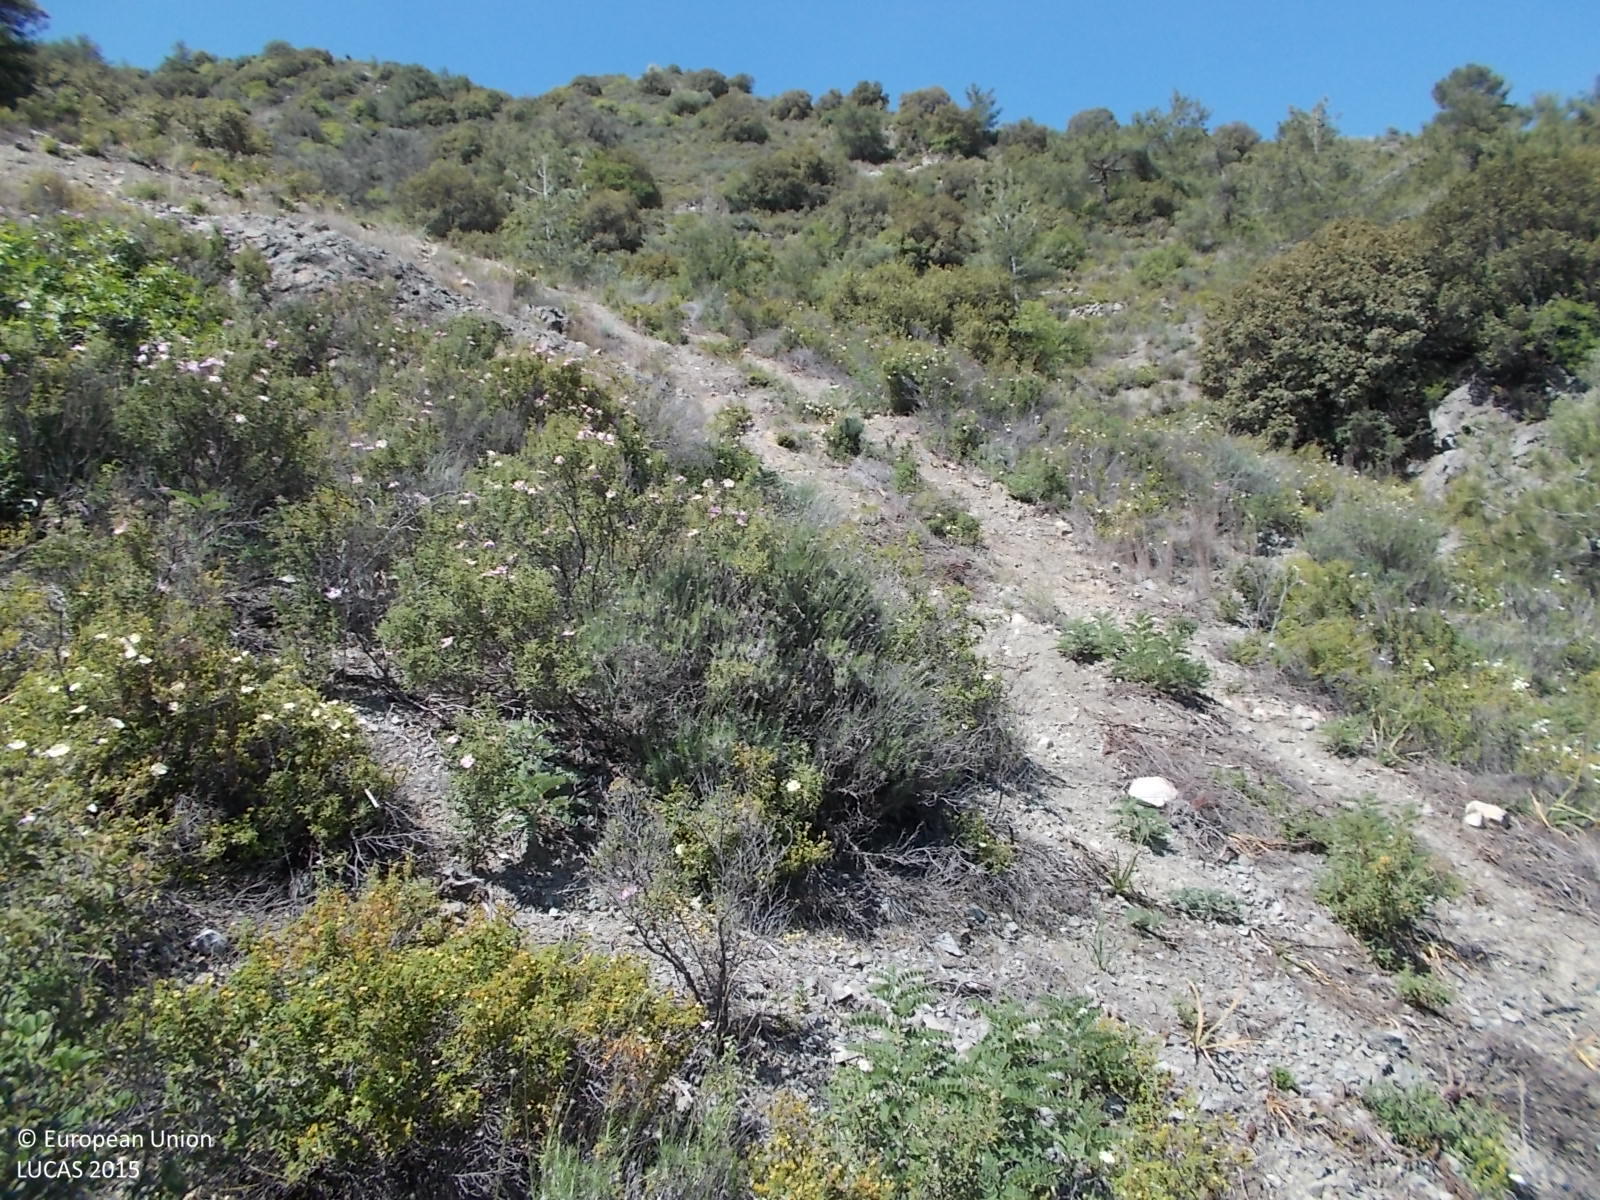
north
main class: Shrubland
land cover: Shrubland with sparse tree cover
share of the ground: 50 - 75 %
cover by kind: shrubs 75 %, unconsolidated bare surface 15 %, broadleaved forest trees 5 %, consolidated bare surface 5 %
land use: Forestry
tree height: > 5 m
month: May
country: CY
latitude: 34.8582
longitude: 33.0419
